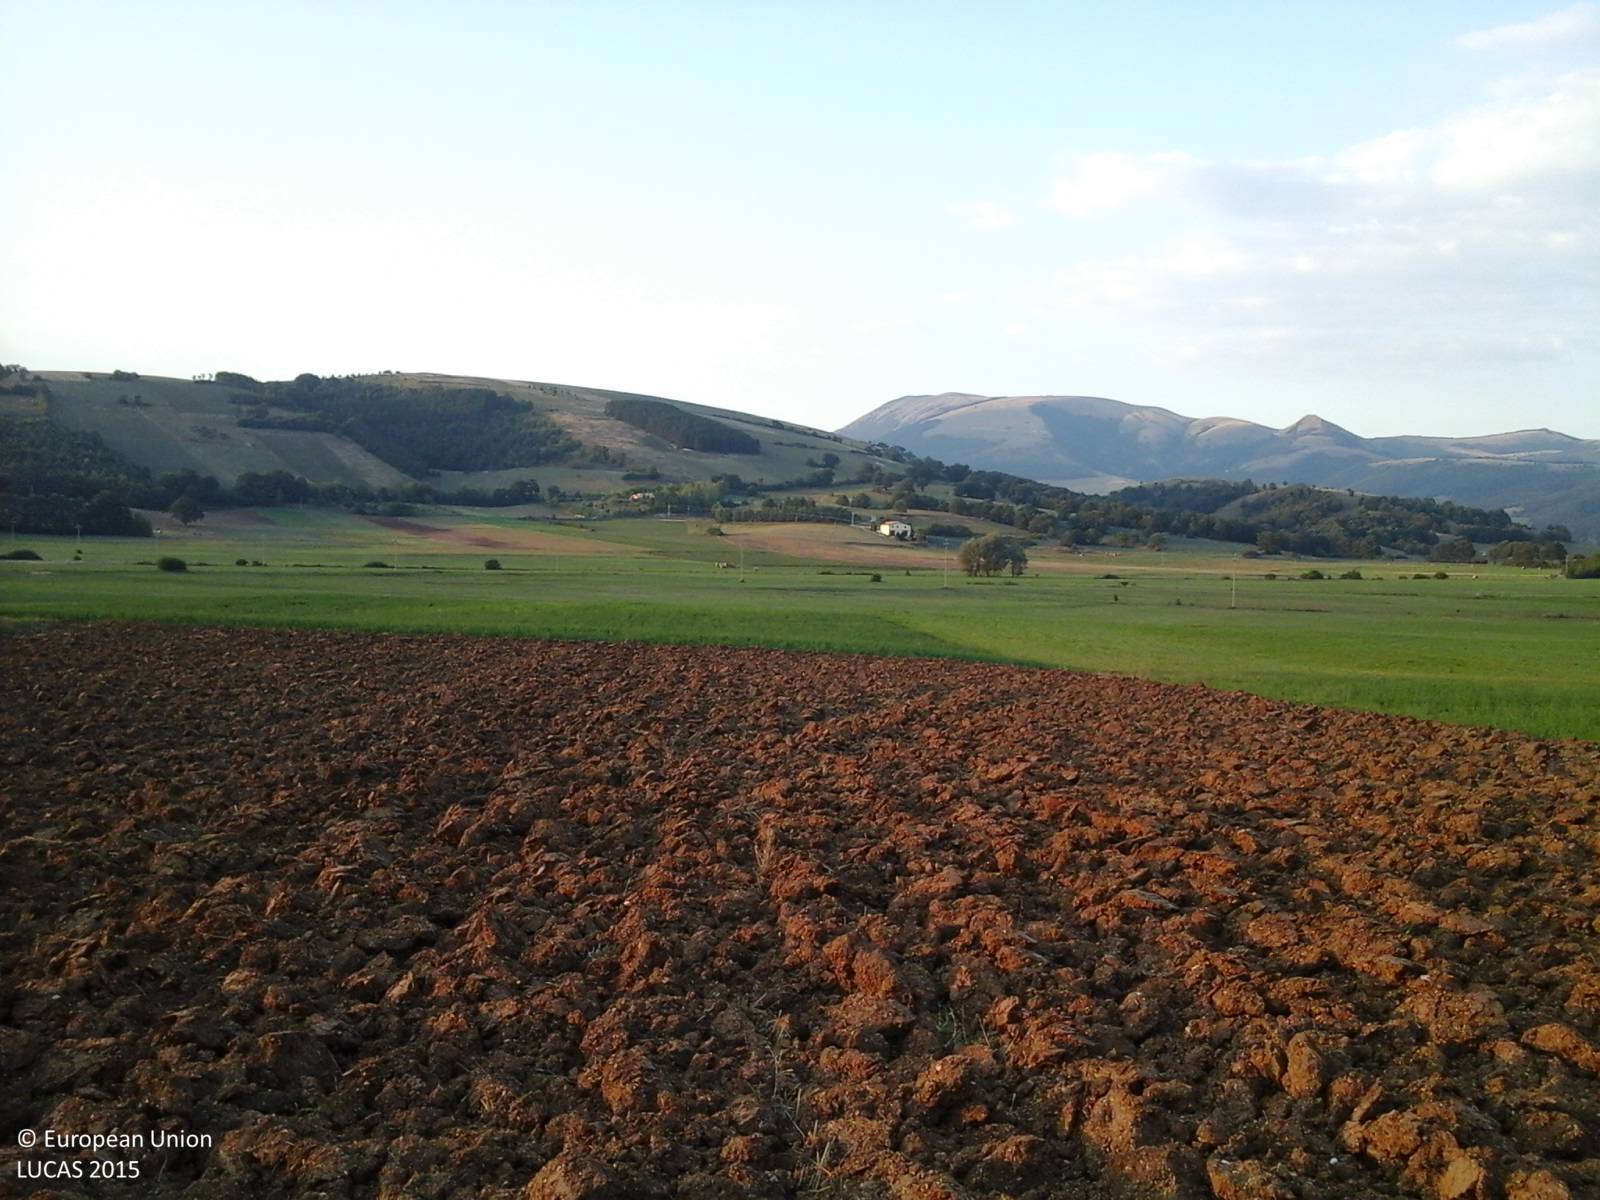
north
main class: Cropland
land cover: Durum wheat
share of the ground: < 10 %
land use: Agriculture (excluding fallow land and kitchen gardens)
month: August
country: IT
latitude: 43.0295
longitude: 12.8513
